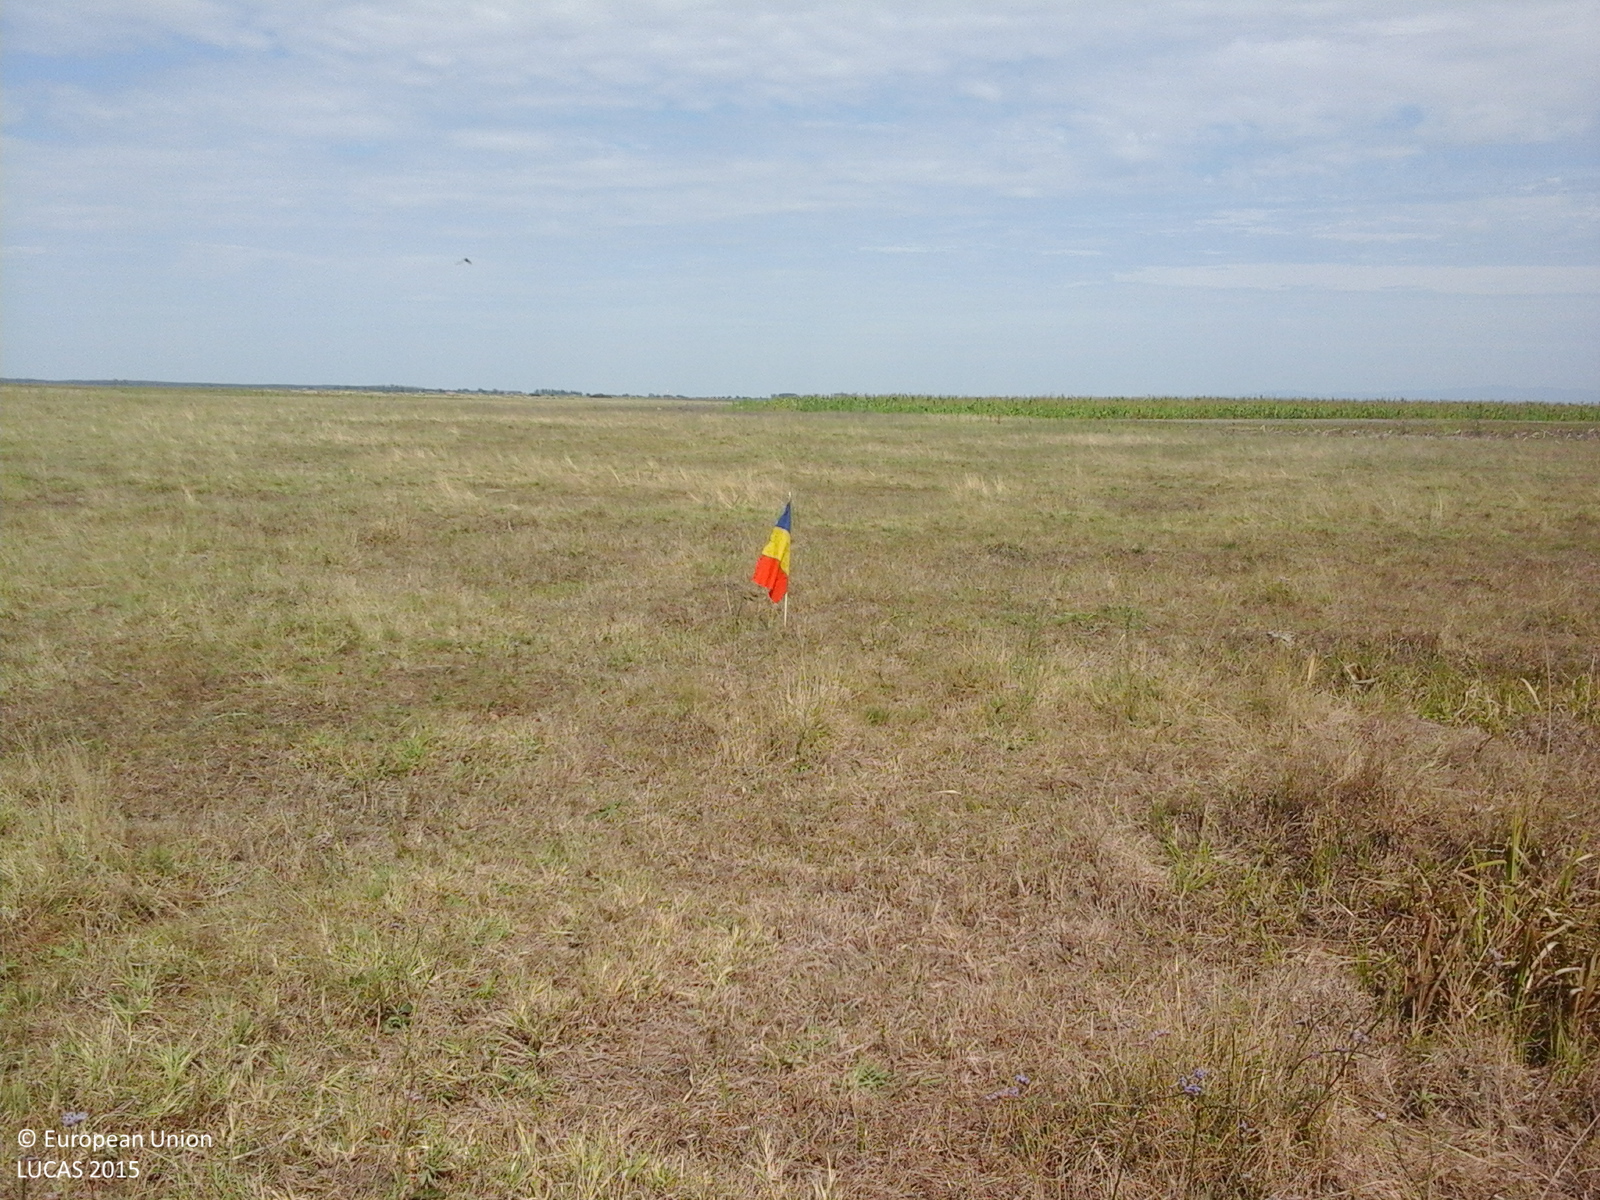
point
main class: Grassland
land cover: Grassland without tree/shrub cover
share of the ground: > 75 %
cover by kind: herbaceous plants 100 %
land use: Agriculture (excluding fallow land and kitchen gardens)
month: August
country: RO
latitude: 46.4169
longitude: 21.5259
